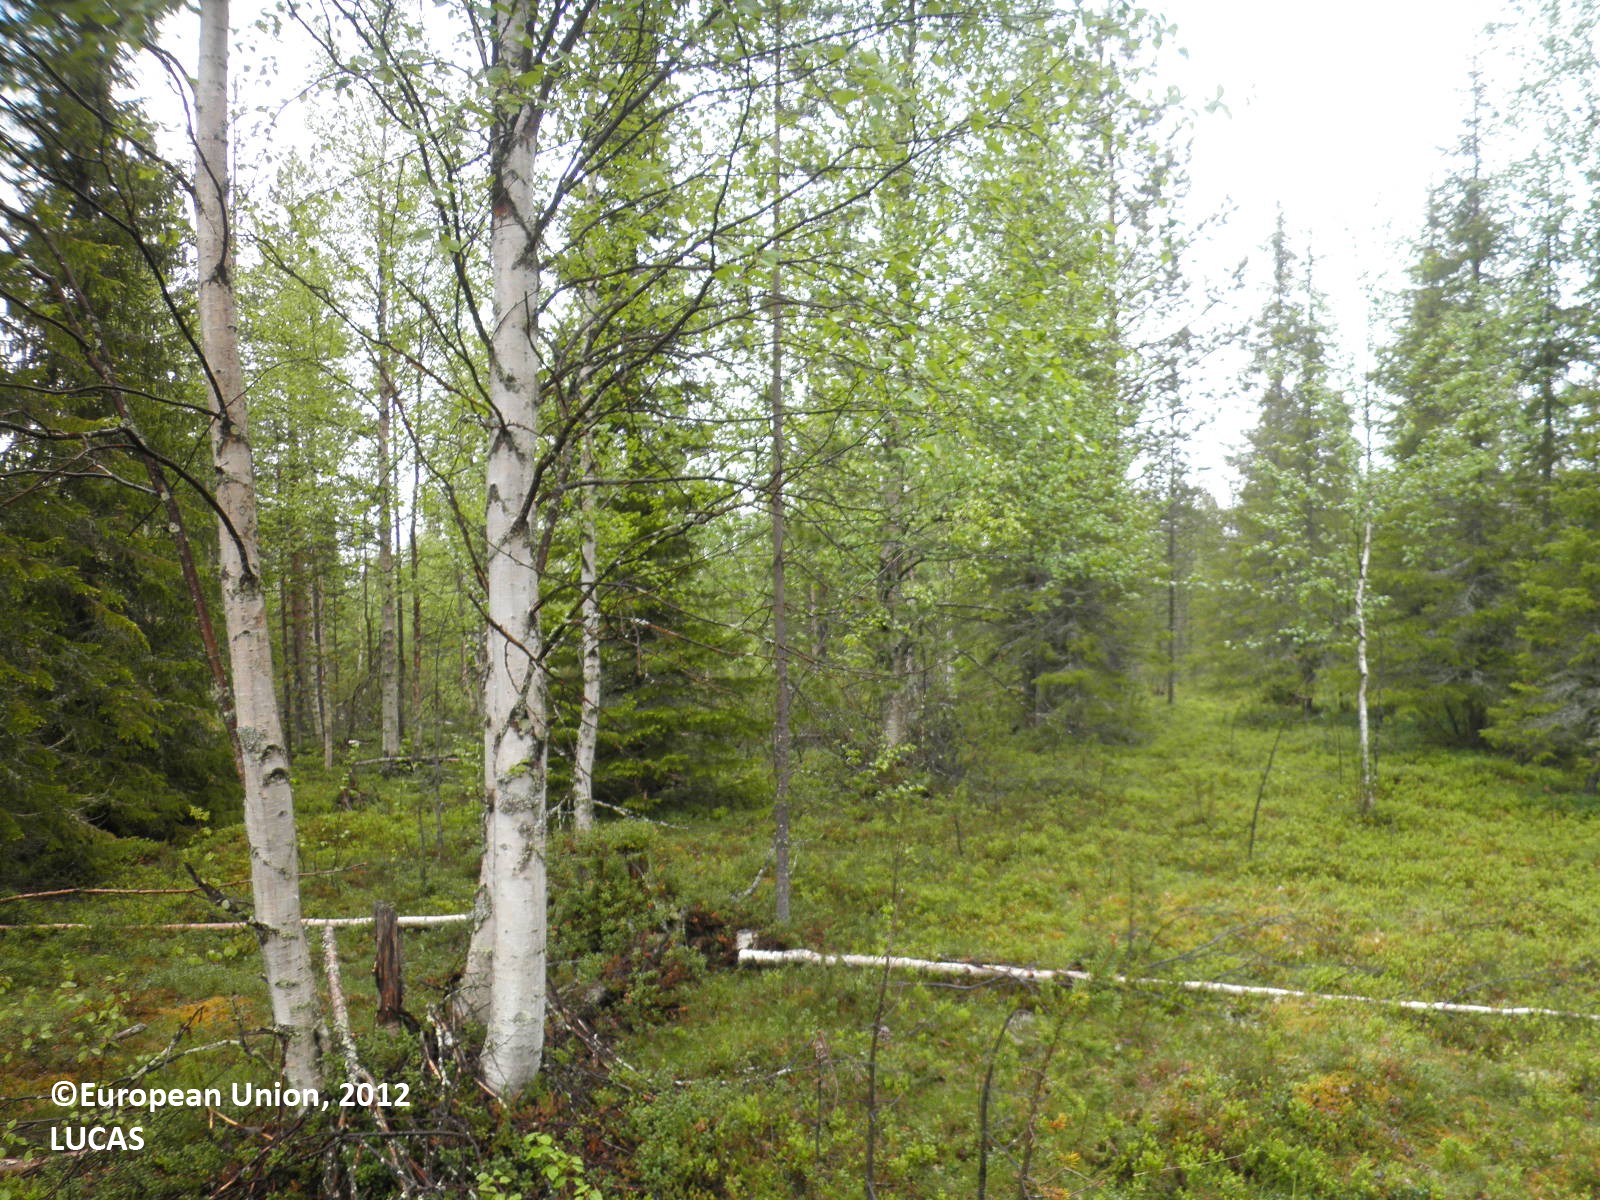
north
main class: Woodland
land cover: Spruce dominated mixed woodland
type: boreal forest
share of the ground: 50 - 75 %
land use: Forestry
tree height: > 5 m
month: June
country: FI
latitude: 67.9718
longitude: 25.6459
